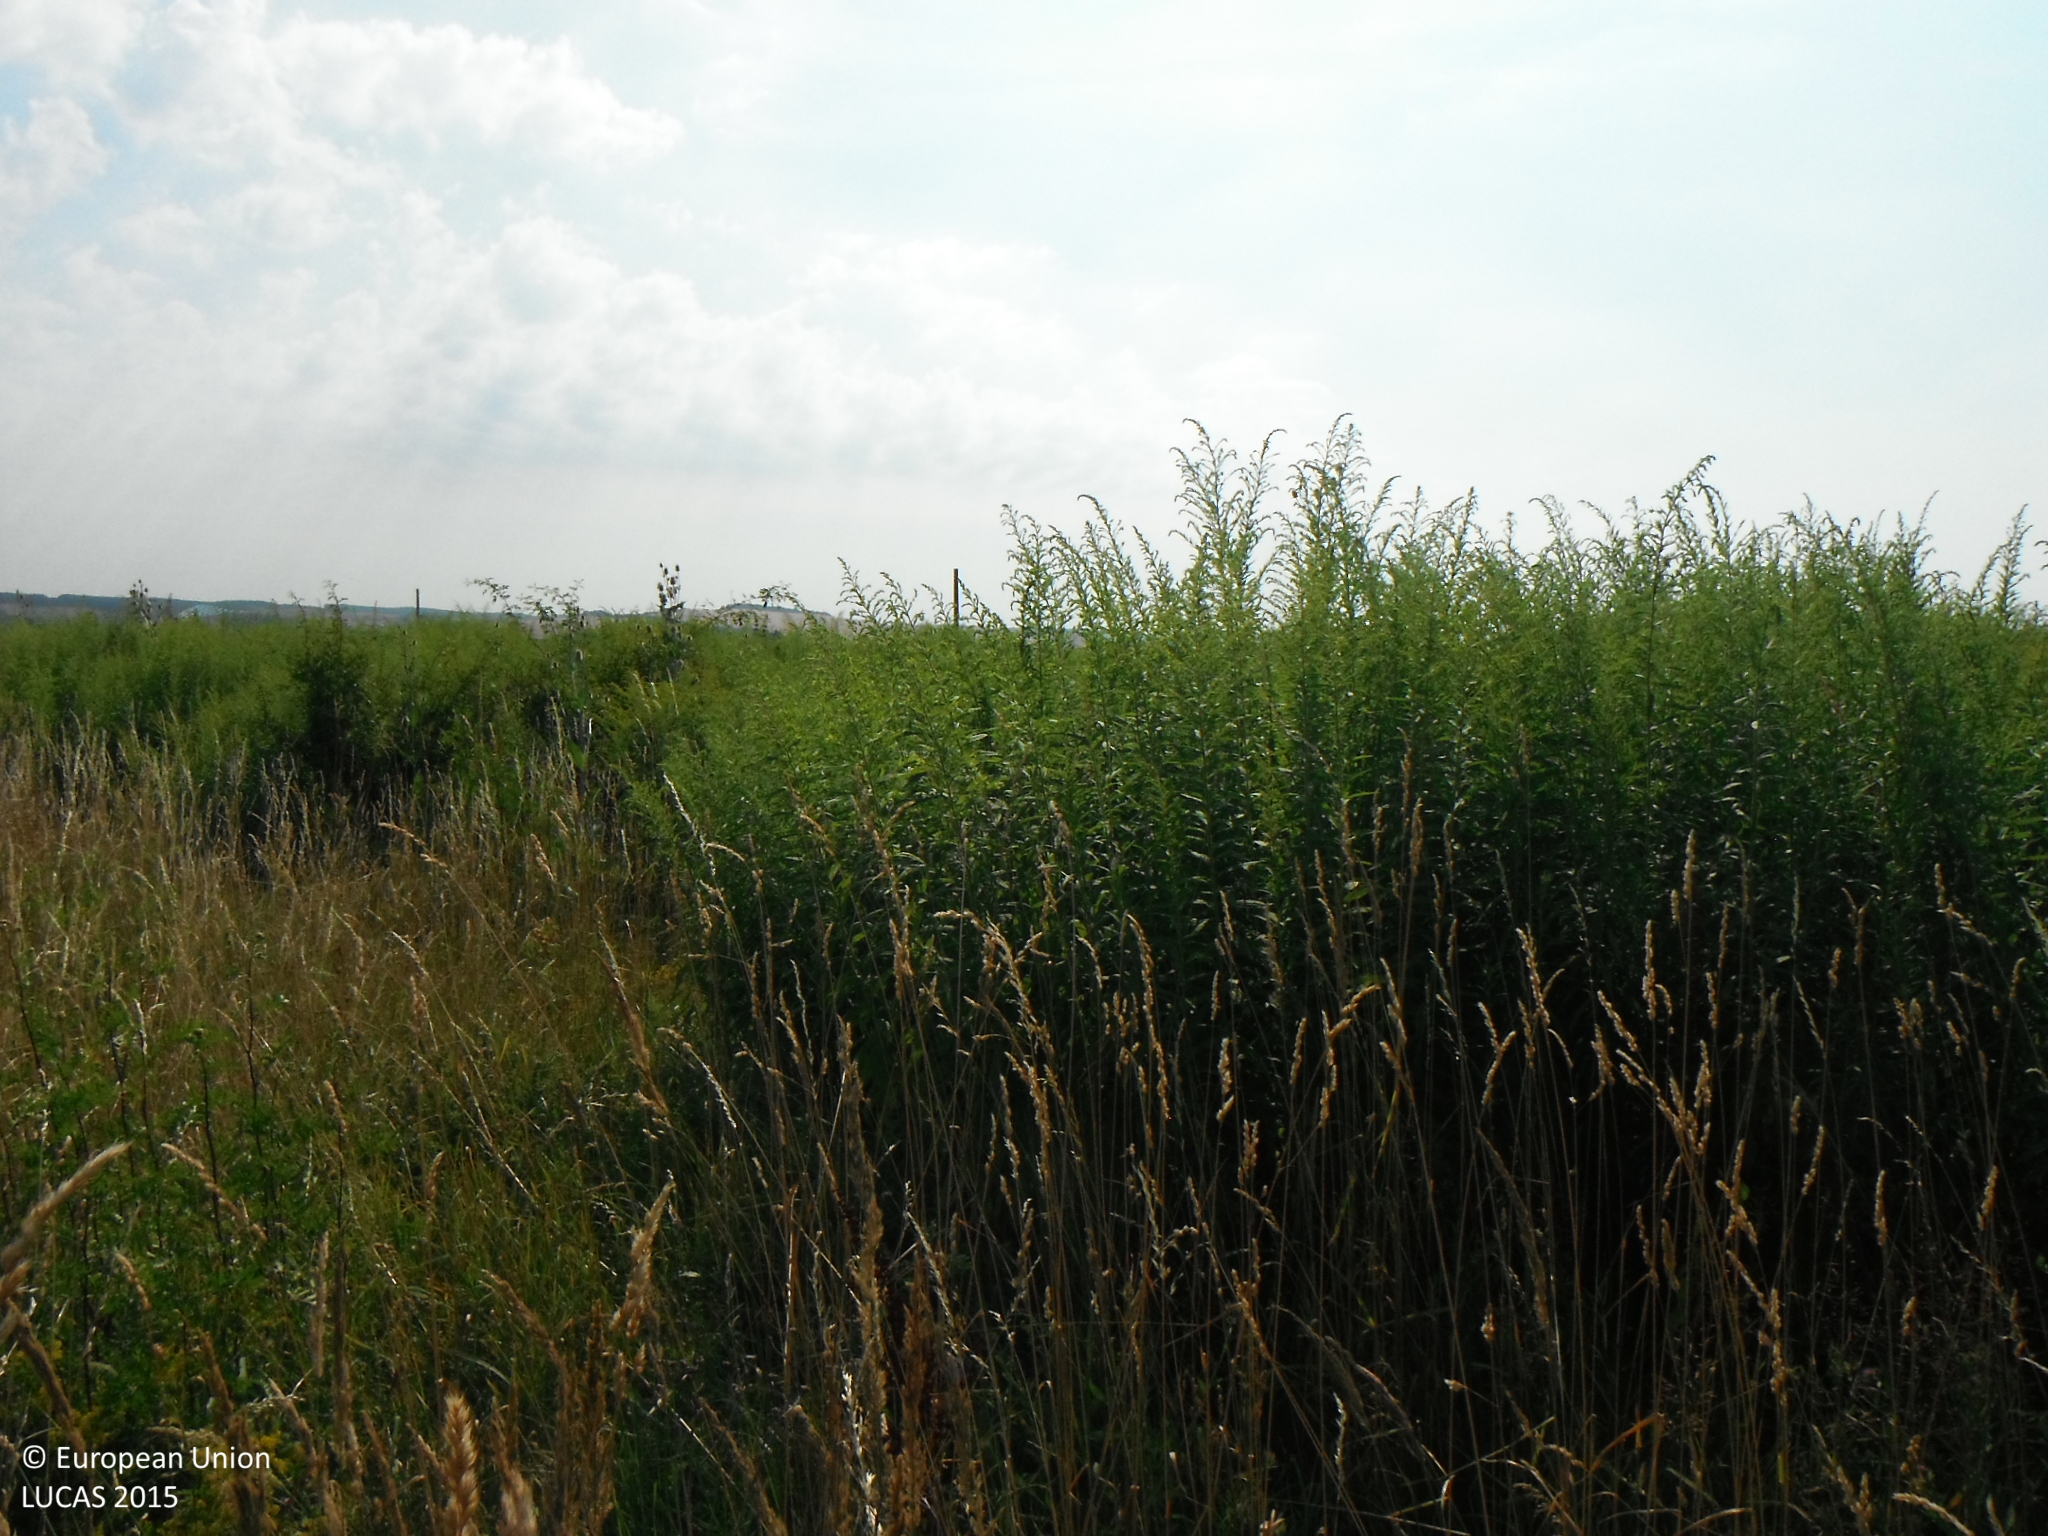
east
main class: Grassland
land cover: Spontaneously vegetated surfaces
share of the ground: > 75 %
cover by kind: herbaceous plants 100 %
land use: Semi-natural and natural areas not in use
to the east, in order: Spontaneously vegetated surfaces; Fences; Rape and turnip rape; Electric lines; Grass margins; Soya
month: July
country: SK
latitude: 48.3656
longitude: 20.0043
